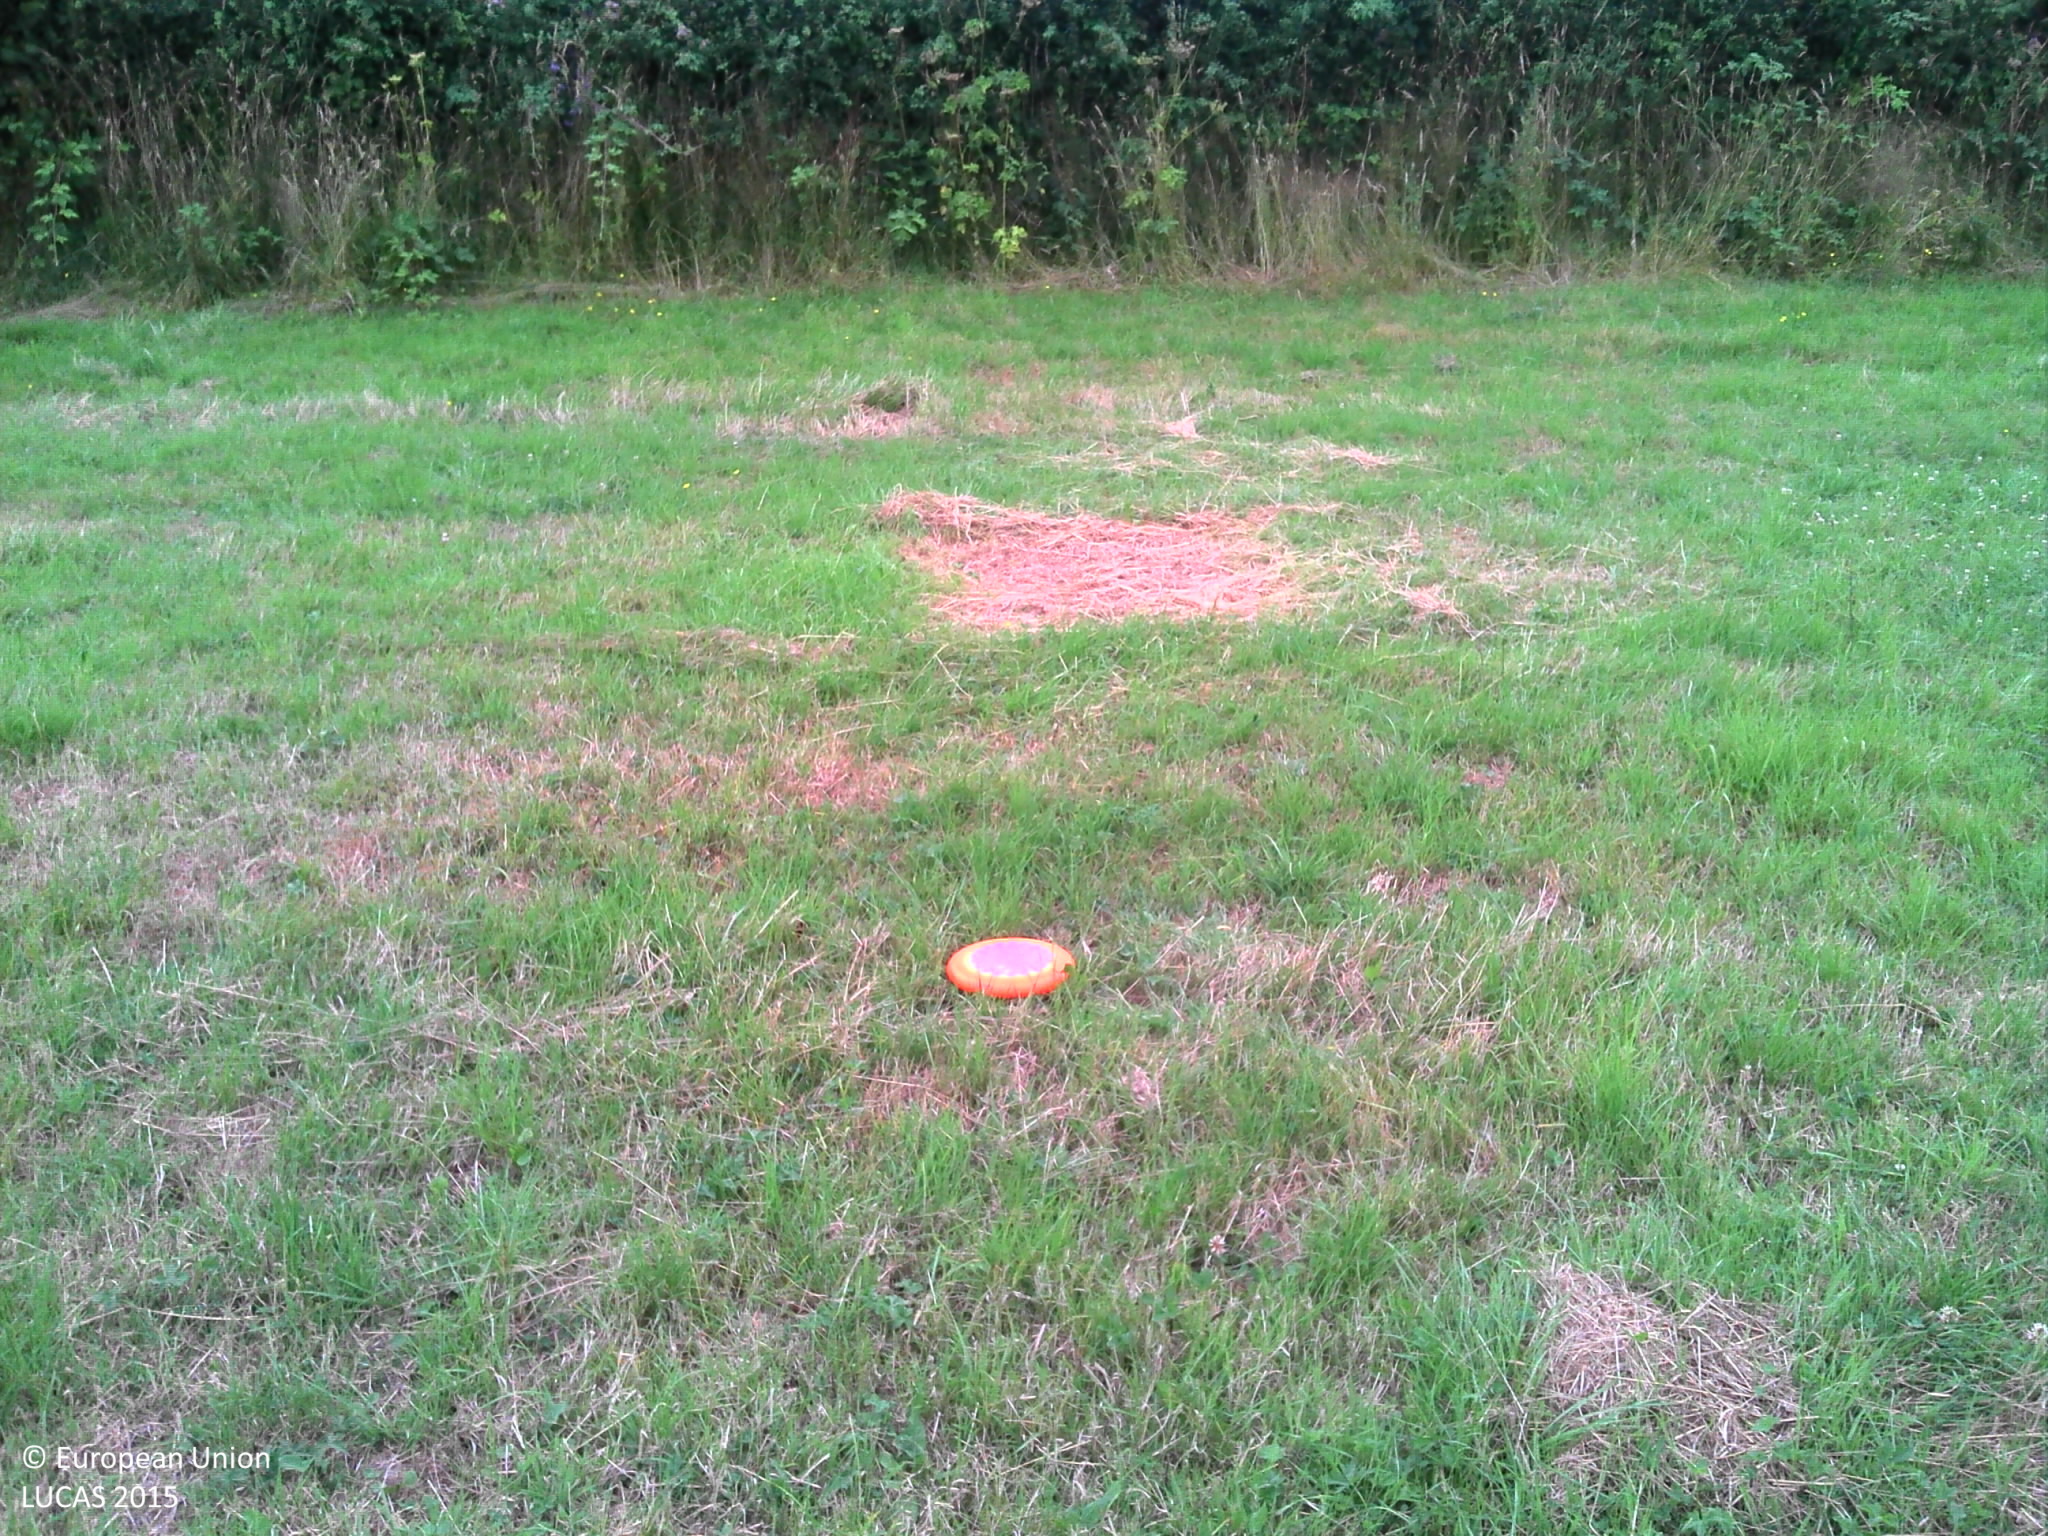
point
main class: Grassland
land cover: Grassland without tree/shrub cover
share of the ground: > 75 %
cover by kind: herbaceous plants 100 %
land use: Agriculture (excluding fallow land and kitchen gardens)
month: July
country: FR
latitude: 48.4221
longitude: -0.1794
